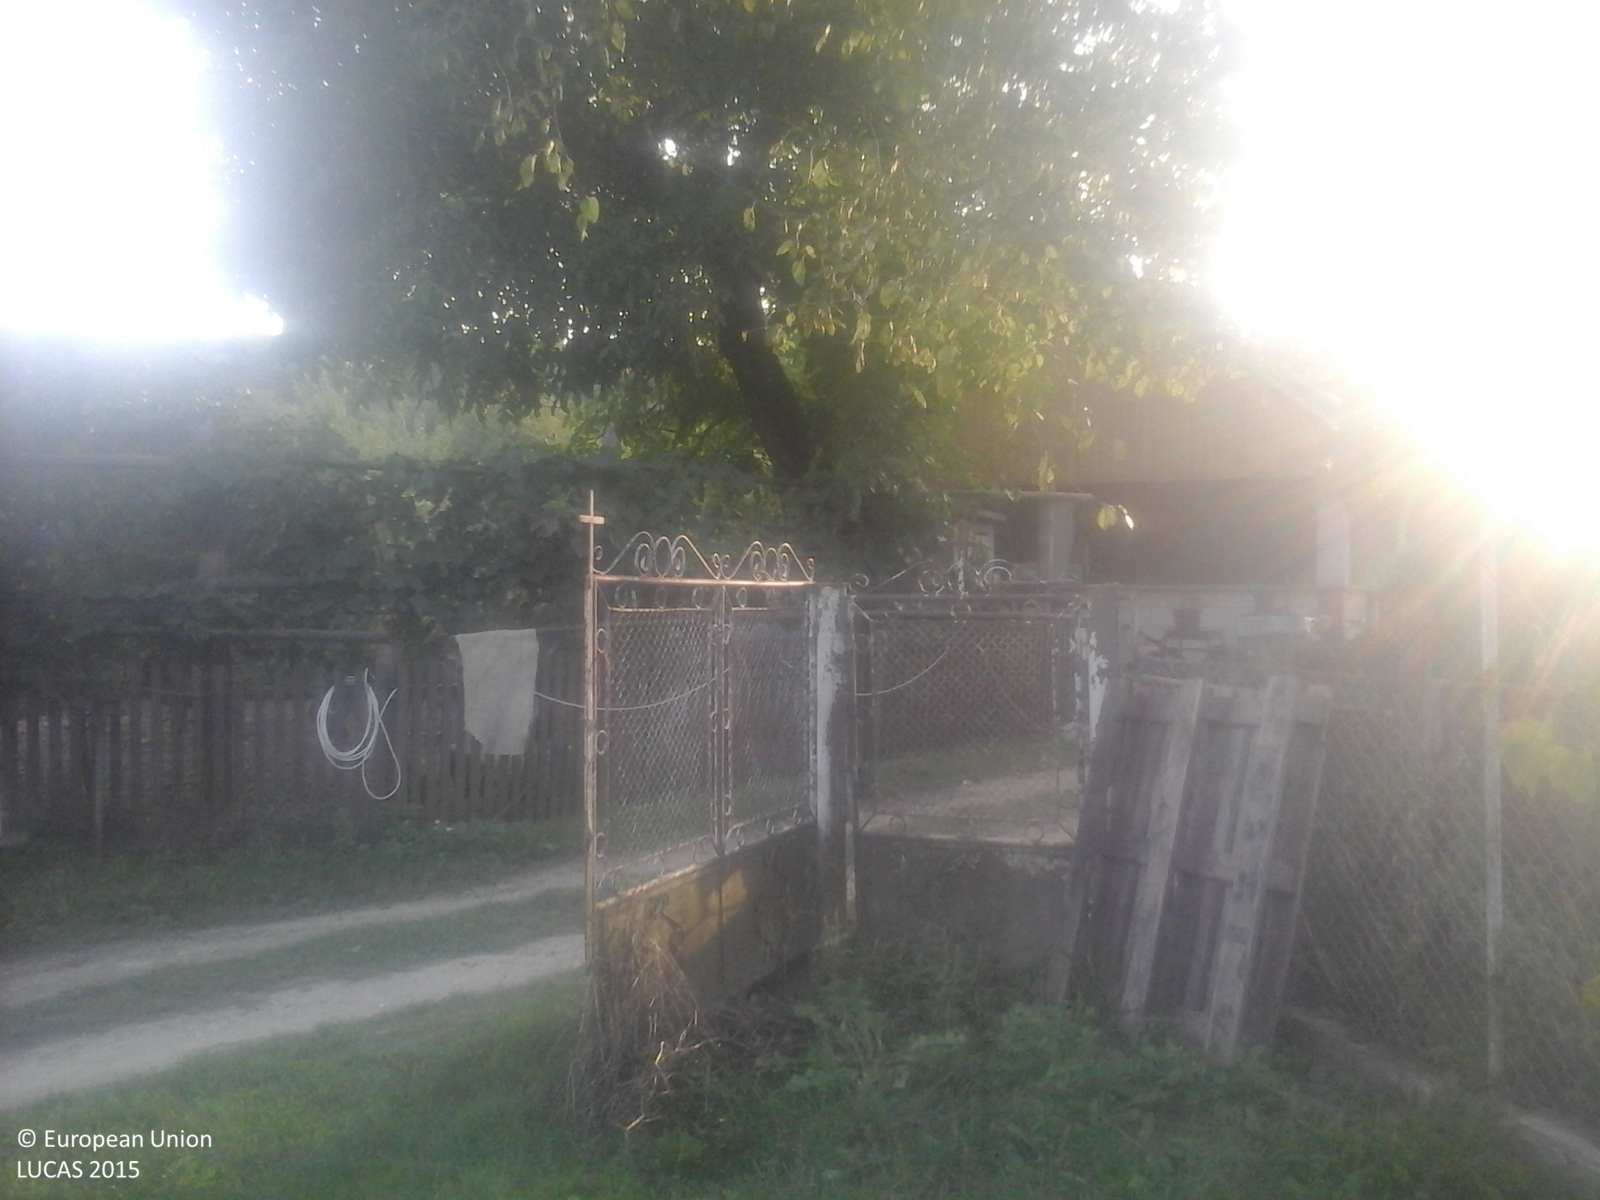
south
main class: Cropland
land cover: Apple fruit
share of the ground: 25 - 50 %
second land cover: Grassland without tree/shrub cover
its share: > 75 %
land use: Agriculture (excluding fallow land and kitchen gardens)
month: September
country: RO
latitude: 47.0745
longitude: 23.0887
